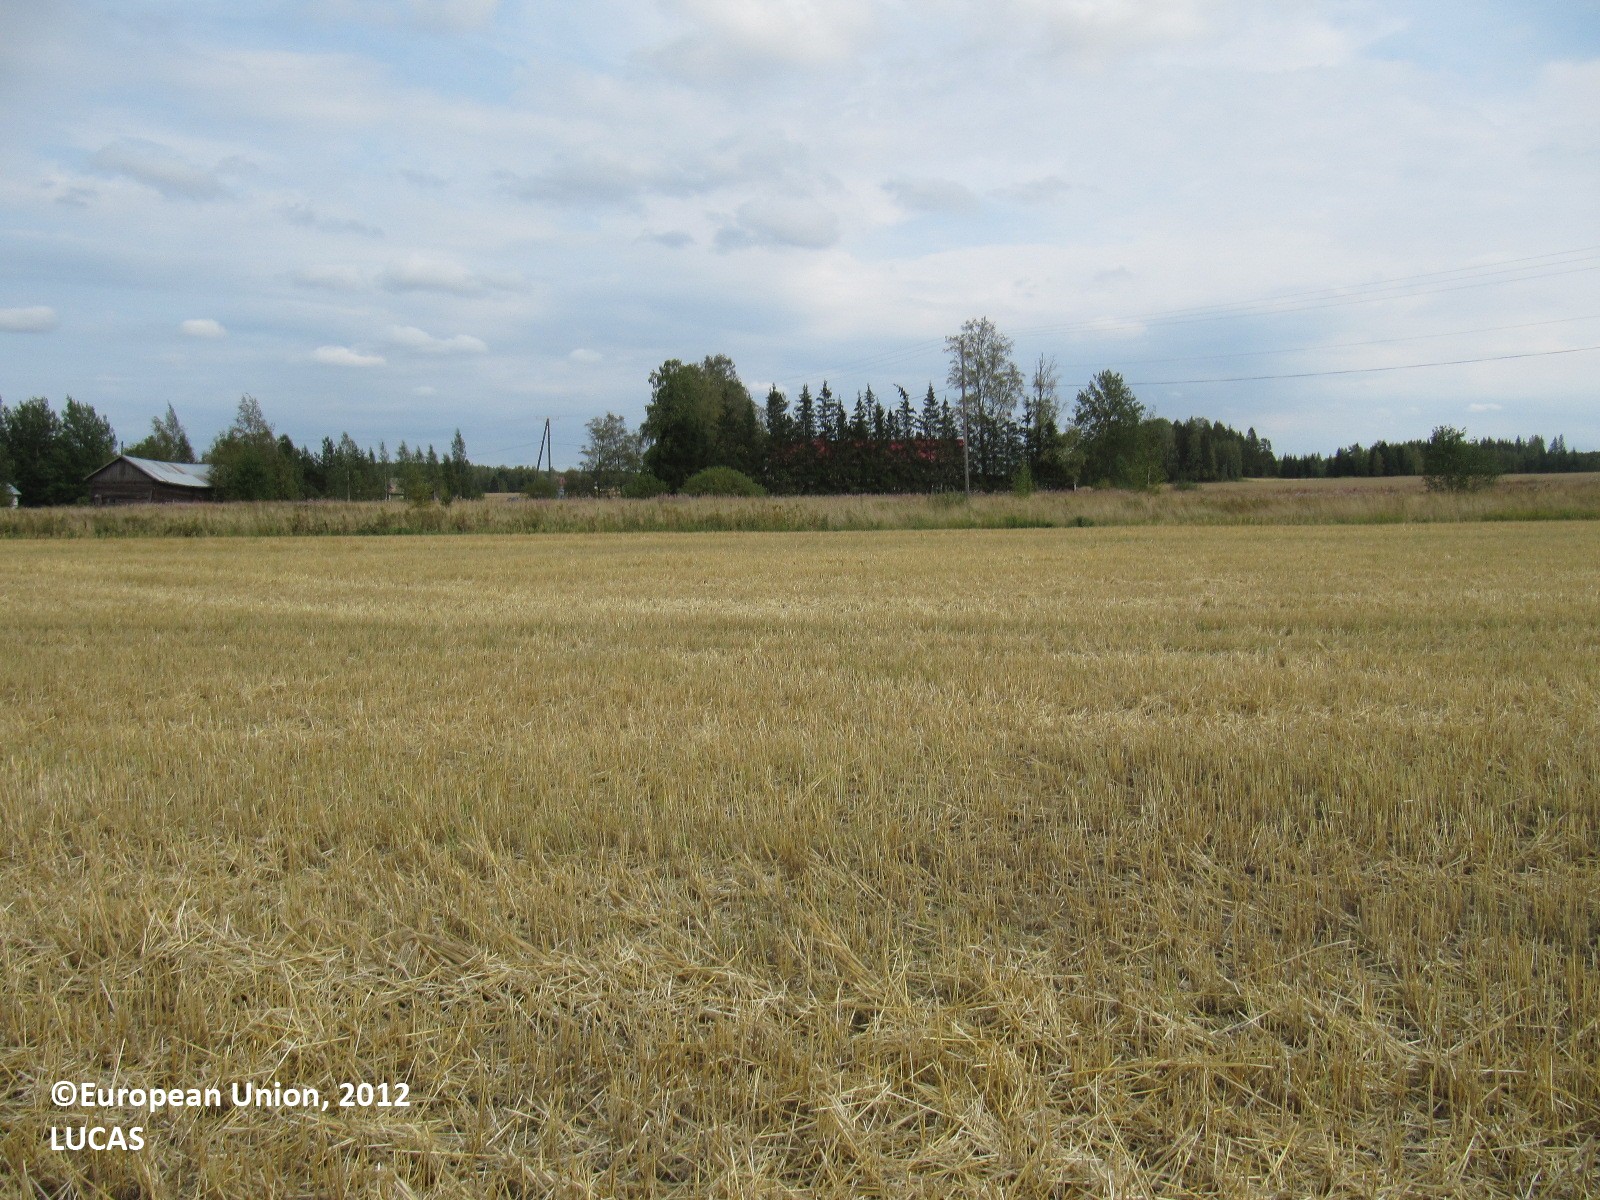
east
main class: Cropland
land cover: Barley
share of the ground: > 75 %
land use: Agriculture (excluding fallow land and kitchen gardens)
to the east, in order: Barley; Grass margins; Ditches and canals; Spontaneously vegetated surfaces; Electric lines; Spontaneously vegetated surfaces; Ditches and canals; Spruce dominated mixed woodland; Grassland with sparse tree/shrub cover; Tracks; Lines of trees; Spontaneously vegetated surfaces; Ditches and canals; Grass margins; Paved roads, cycling and walking lanes; Grass margins; Ditches and canals; Grass margins; Common wheat
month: August
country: FI
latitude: 61.1389
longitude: 22.9054
